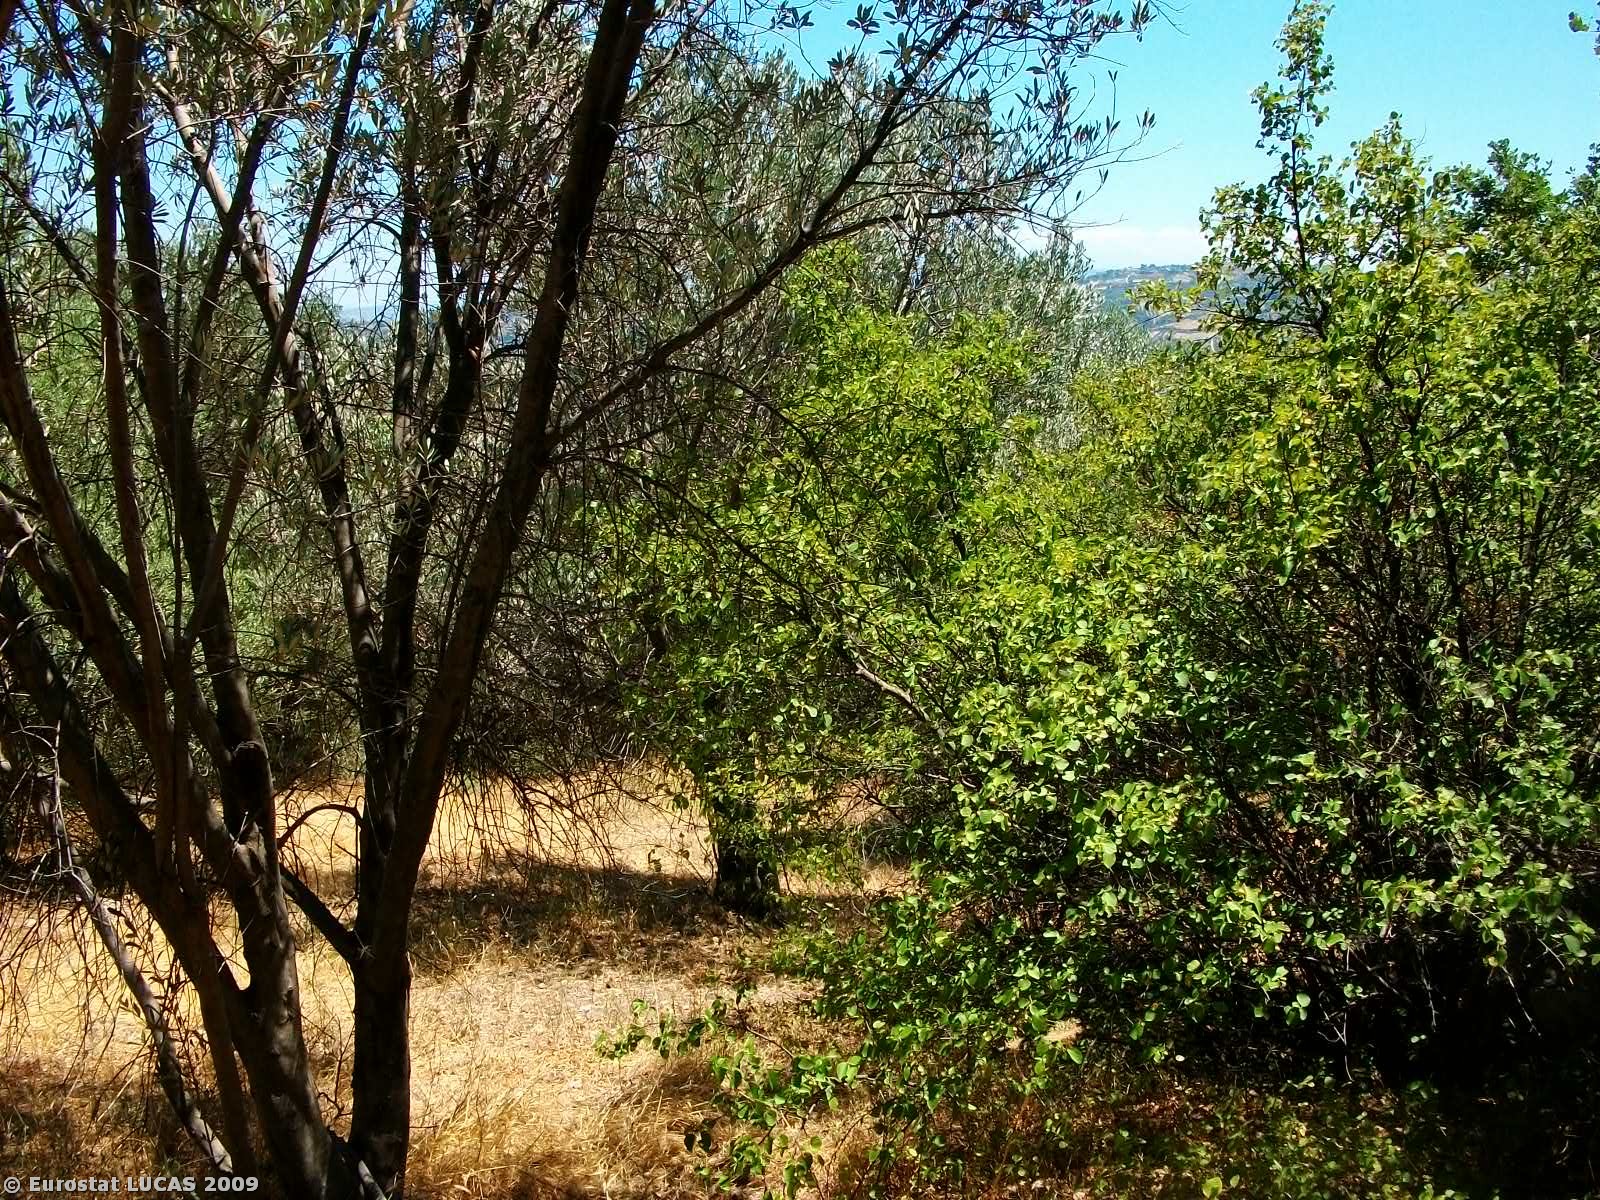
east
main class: Cropland
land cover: Olive groves
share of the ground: 50 - 75 %
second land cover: Bare land
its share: 50 - 75 %
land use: Agriculture (excluding fallow land and kitchen gardens)
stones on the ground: 10 - 25 %
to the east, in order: Olive groves; Bare land; Dry stone walls; Olive groves; Bare land; Dry stone walls; Olive groves; Bare land; Dry stone walls; Olive groves; Bare land; Electric lines; Olive groves; Bare land; Ditches and canals; Olive groves; Bare land; Paved roads, cycling and walking lanes; Olive groves; Bare land; Fences; Shrubland with sparse tree cover; Olive groves; Bare land
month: May
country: GR
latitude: 35.2438
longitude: 24.9905
